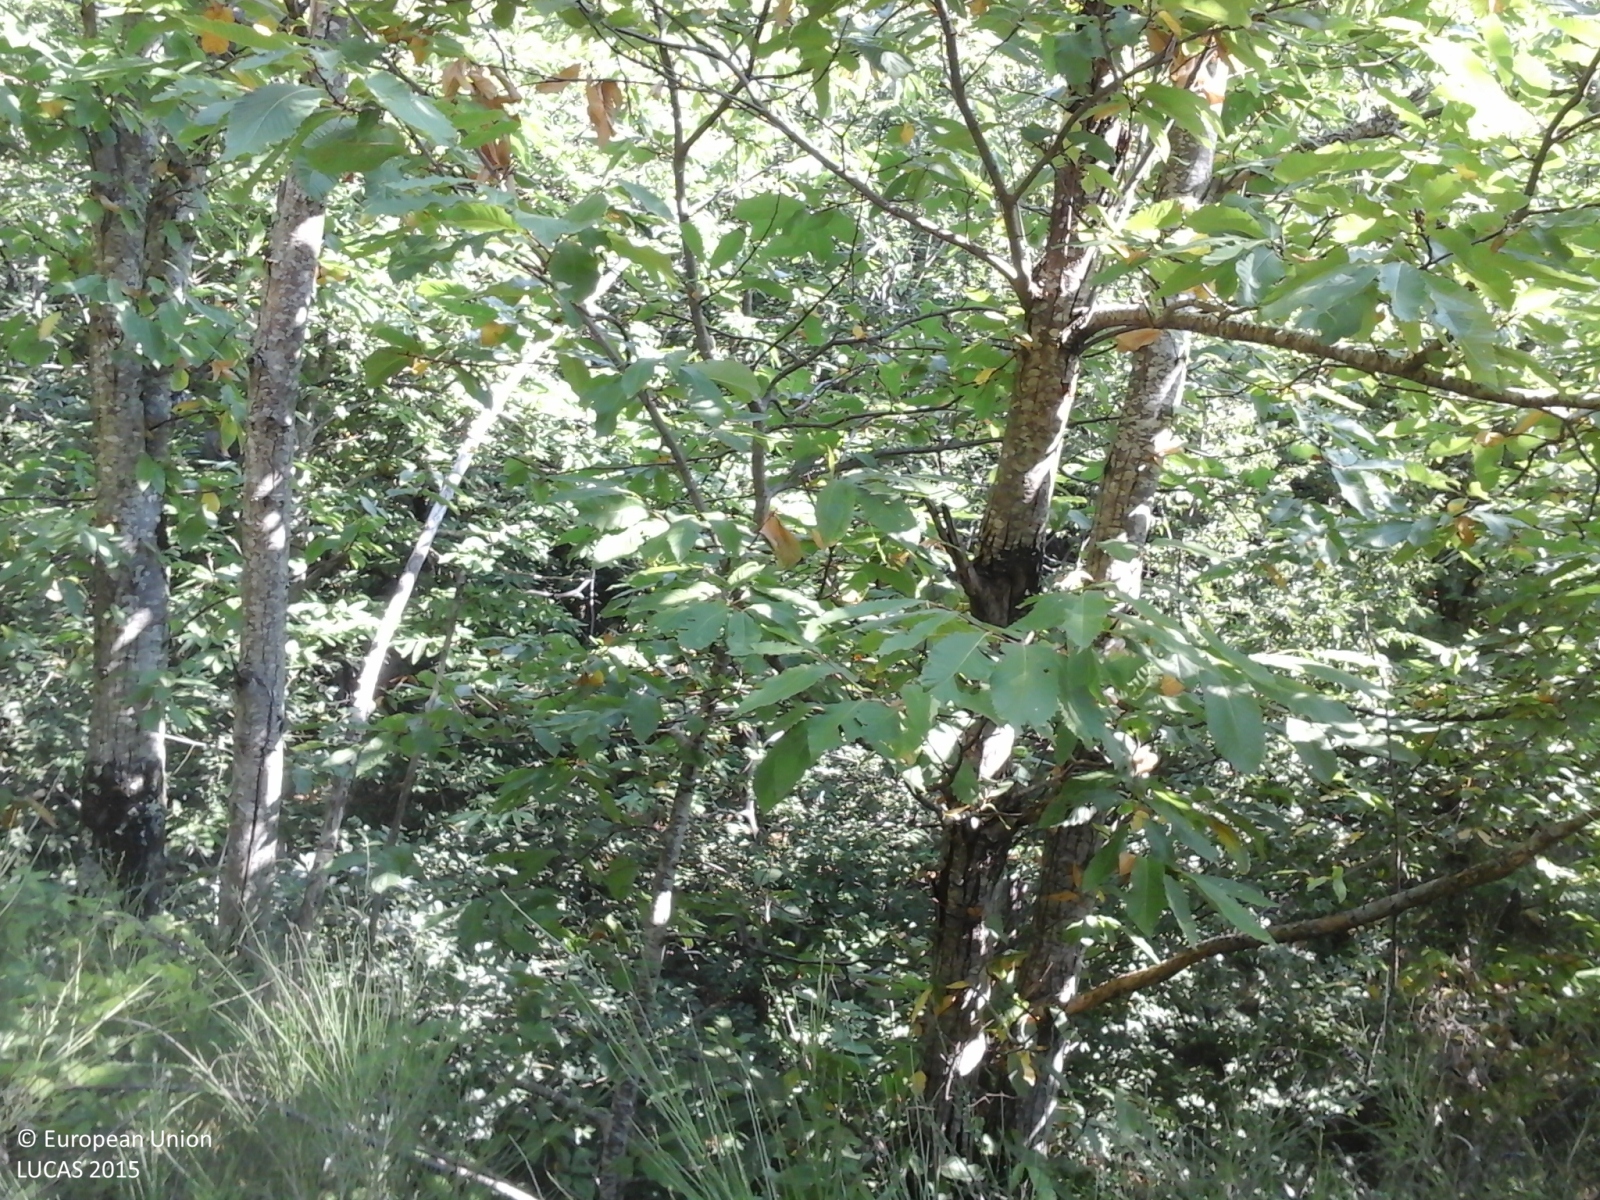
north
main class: Woodland
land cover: Broadleaved woodland
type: thermophilous deciduous forest
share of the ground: > 75 %
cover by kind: broadleaved forest trees 100 %
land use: Forestry
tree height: > 5 m
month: August
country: IT
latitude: 43.9696
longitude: 10.6590
